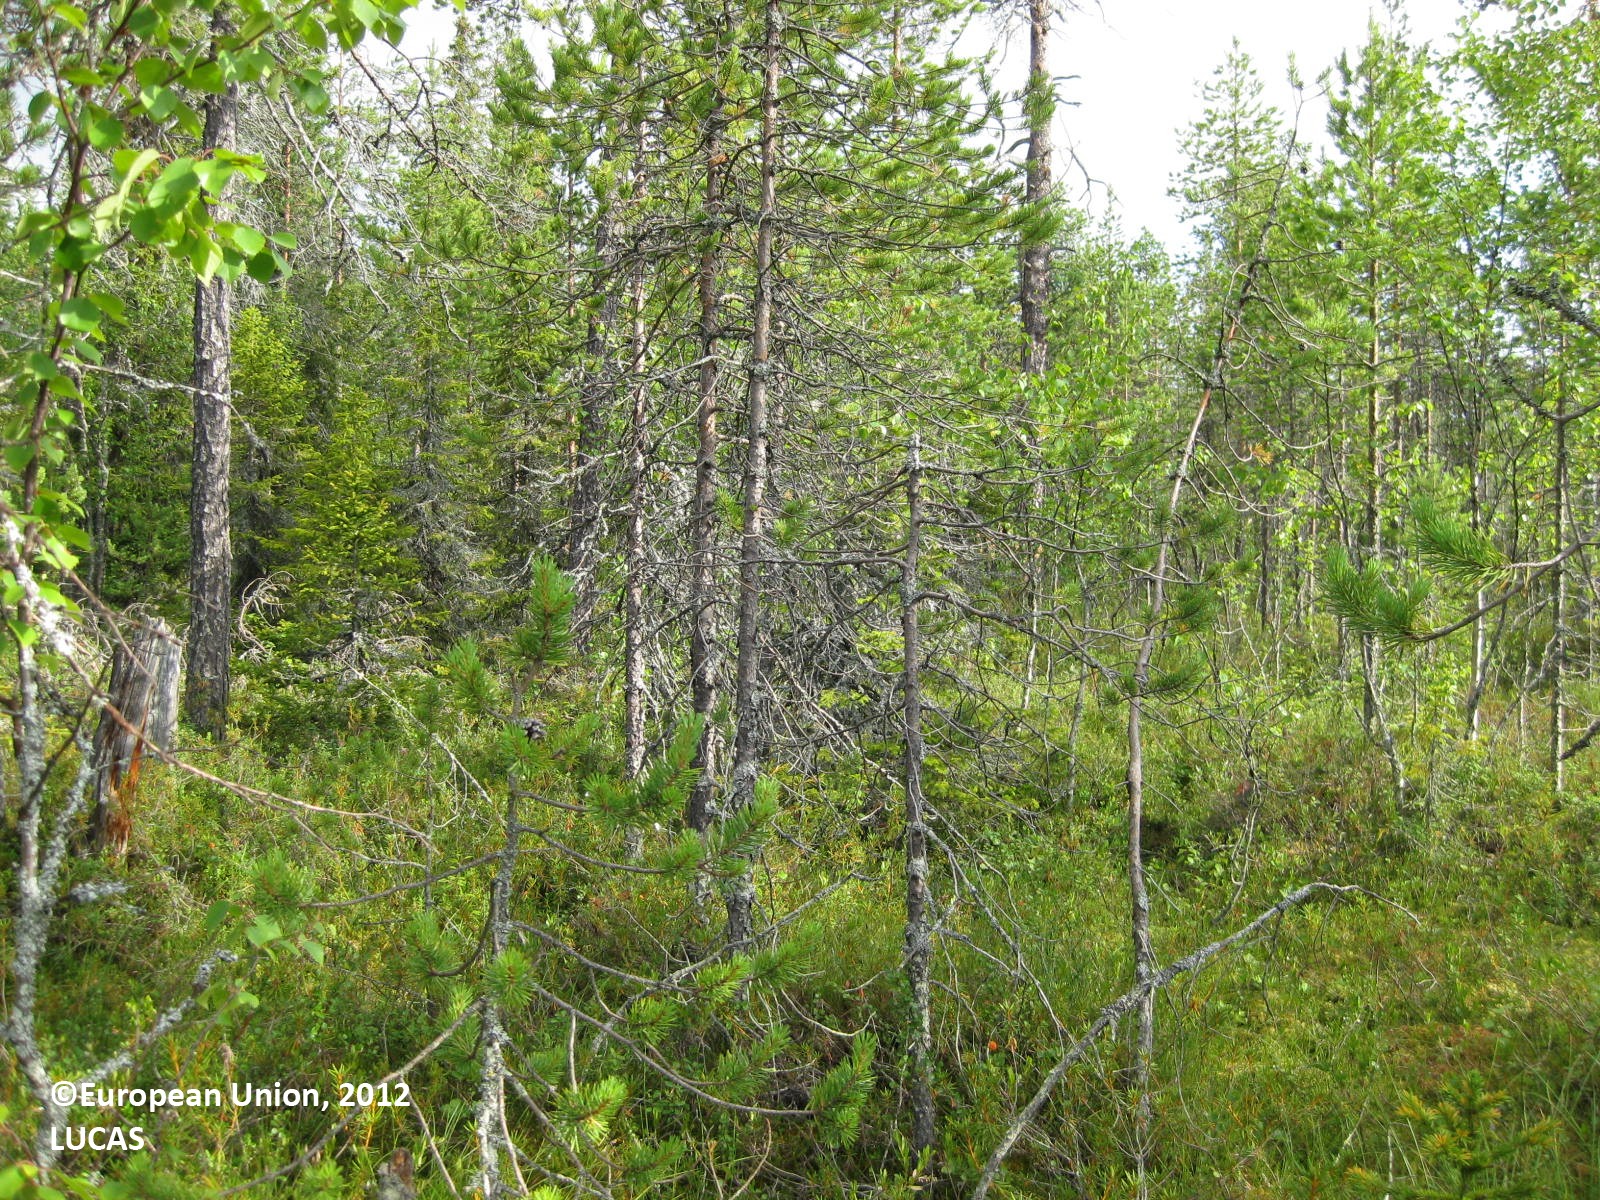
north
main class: Woodland
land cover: Pine dominated coniferous woodland
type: boreal forest
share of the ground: 50 - 75 %
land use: Forestry
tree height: > 5 m
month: July
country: FI
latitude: 65.7679
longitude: 28.6120
